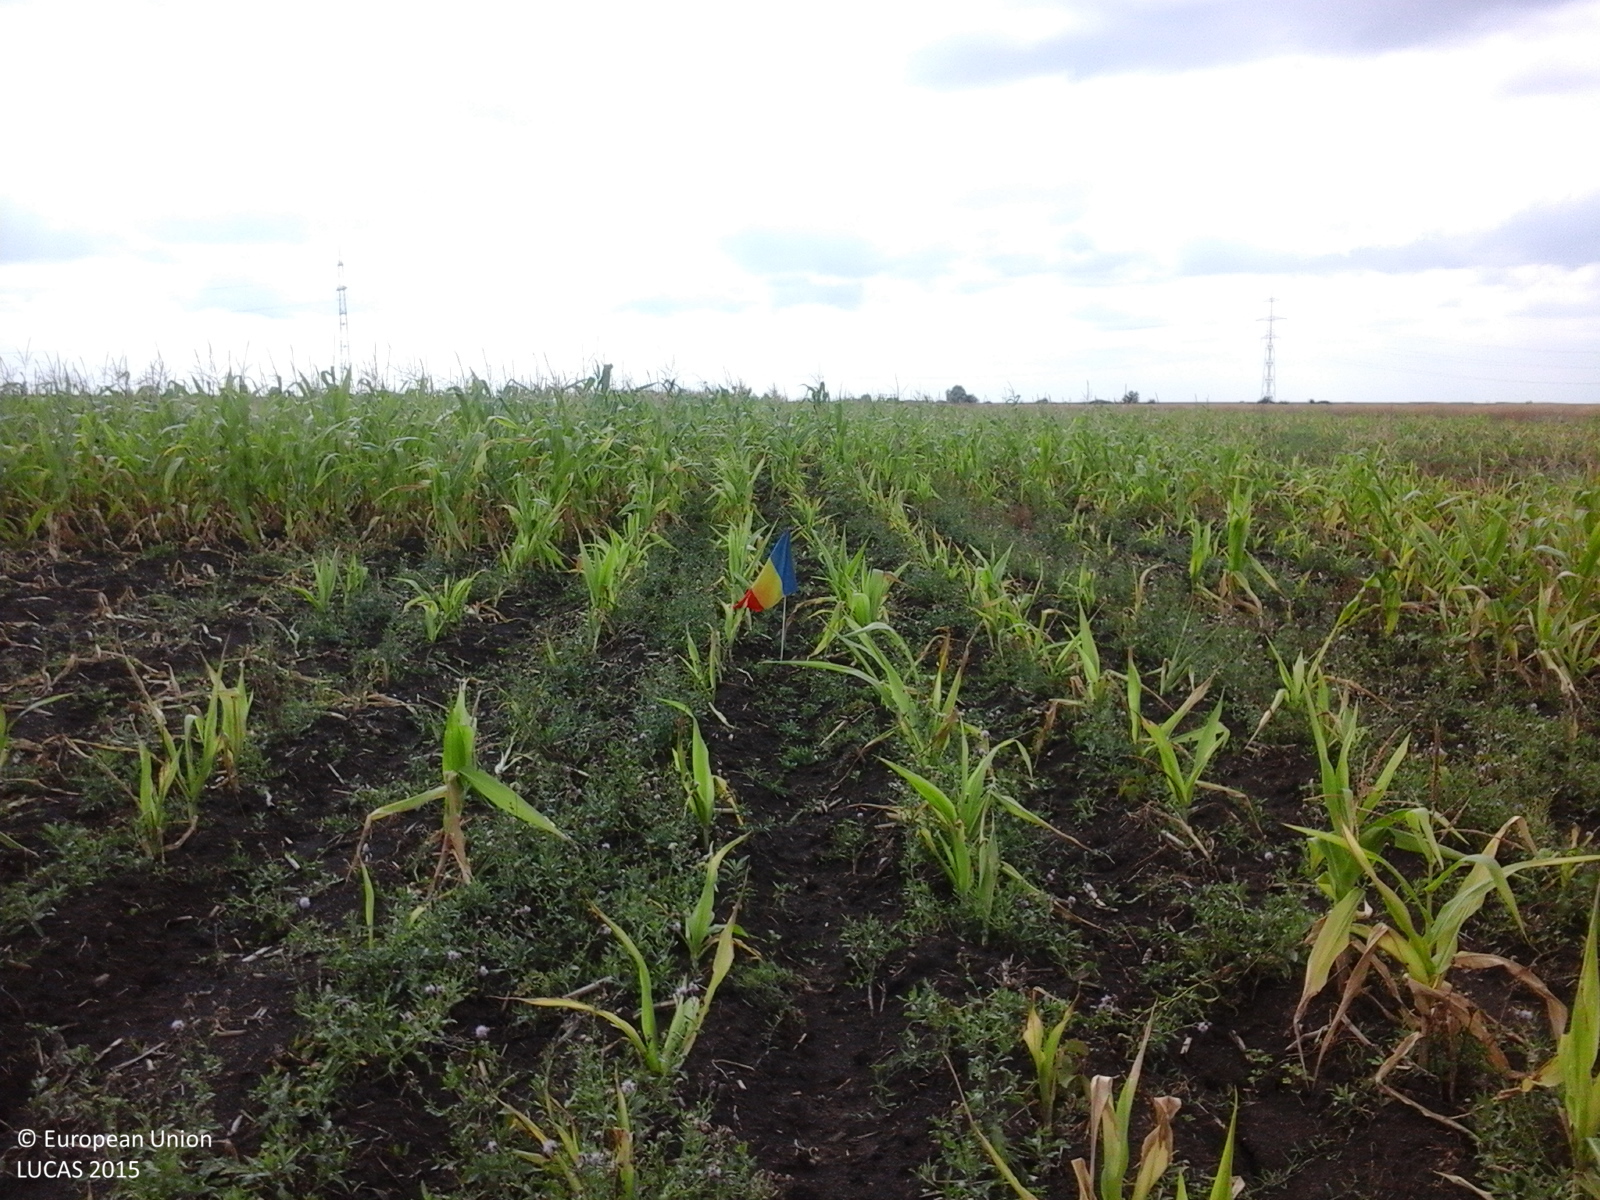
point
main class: Cropland
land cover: Maize
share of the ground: 50 - 75 %
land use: Agriculture (excluding fallow land and kitchen gardens)
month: August
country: RO
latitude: 45.5323
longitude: 21.4669
